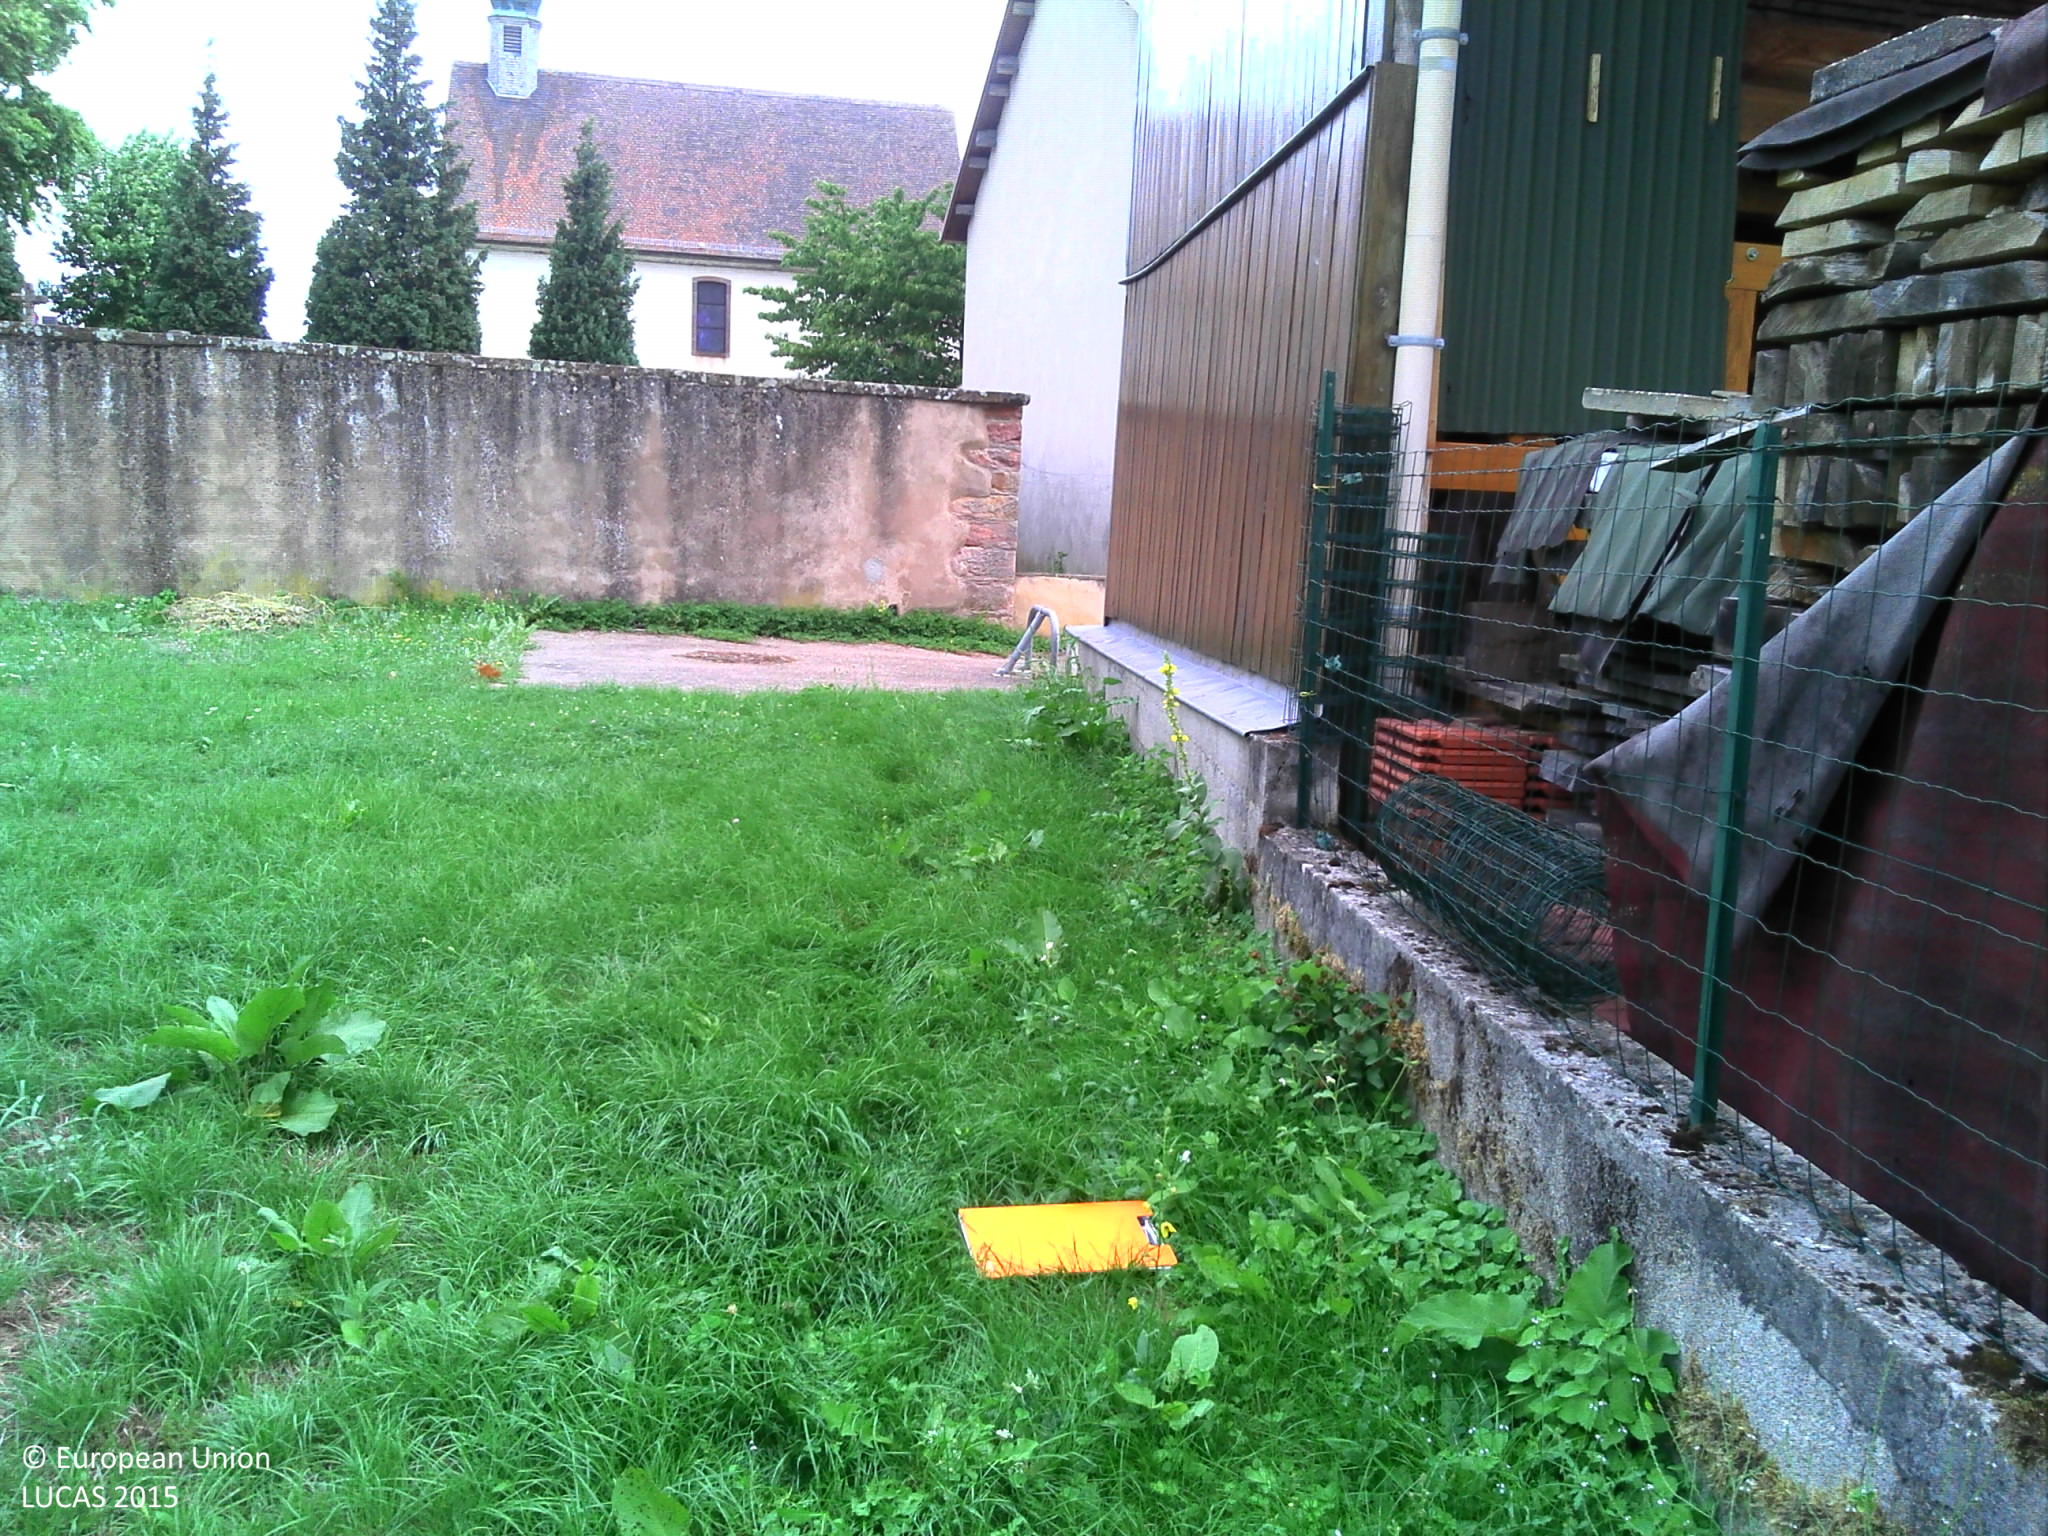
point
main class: Grassland
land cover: Grassland without tree/shrub cover
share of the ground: > 75 %
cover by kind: herbaceous plants 100 %
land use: Agriculture (excluding fallow land and kitchen gardens)
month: September
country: FR
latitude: 48.2283
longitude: 7.3759
